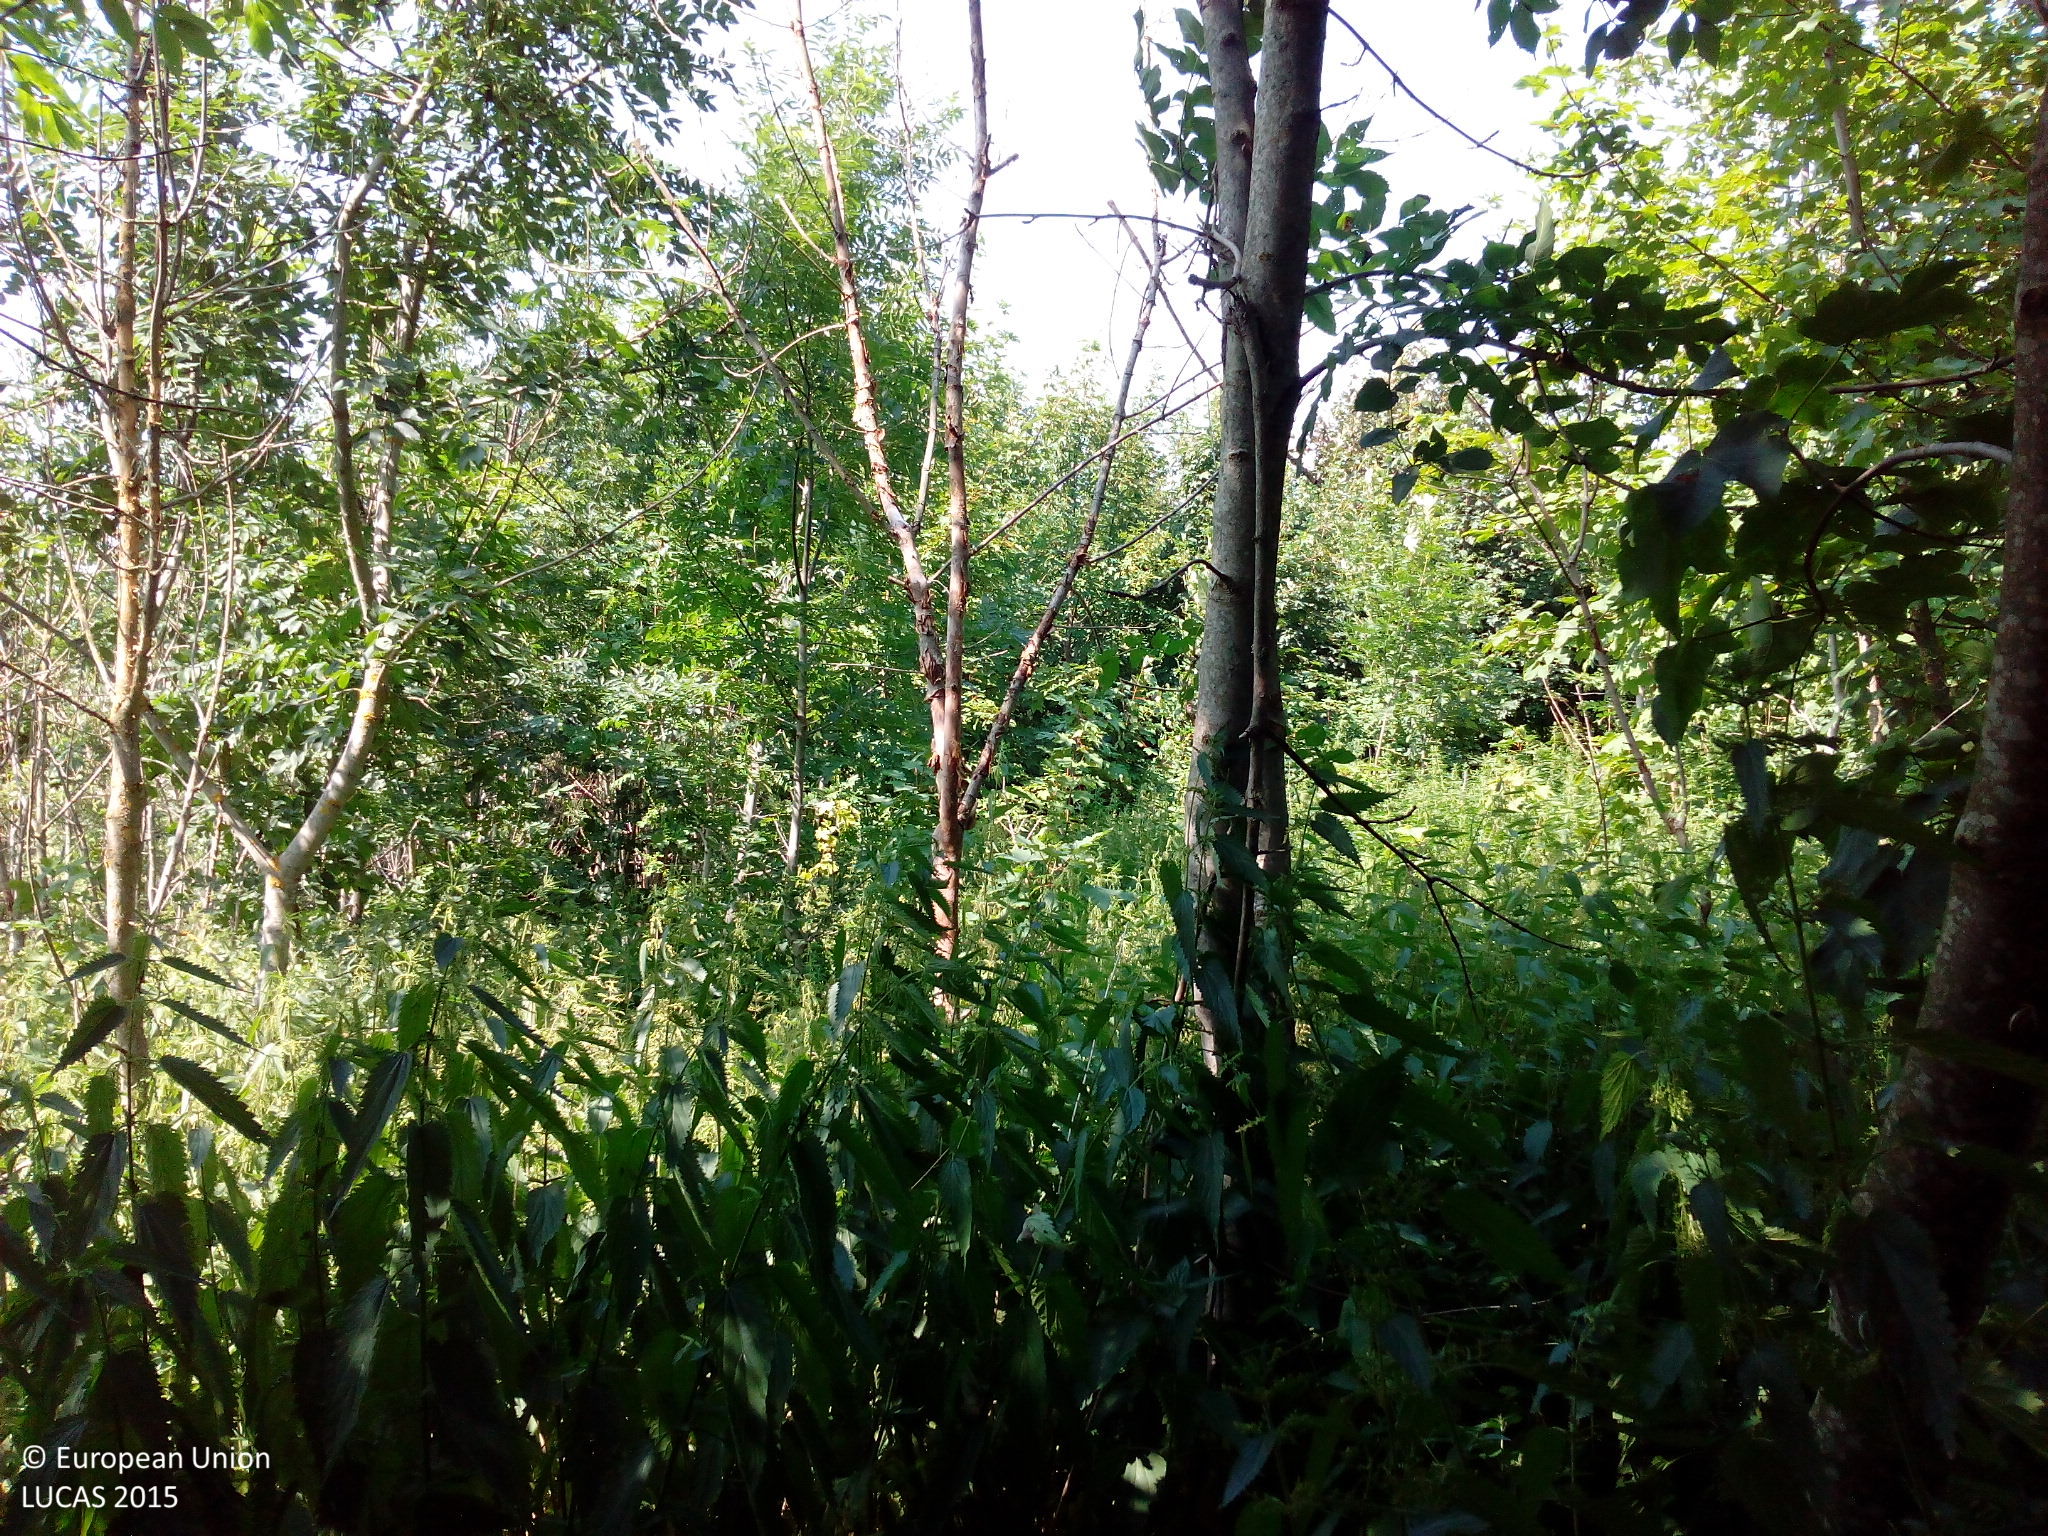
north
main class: Woodland
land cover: Broadleaved woodland
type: mesophytic deciduous forest
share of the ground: 50 - 75 %
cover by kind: broadleaved forest trees 75 %, herbaceous plants 25 %
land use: Forestry
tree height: < 5 m
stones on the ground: < 10 %
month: July
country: DE
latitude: 48.5290
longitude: 9.6887
